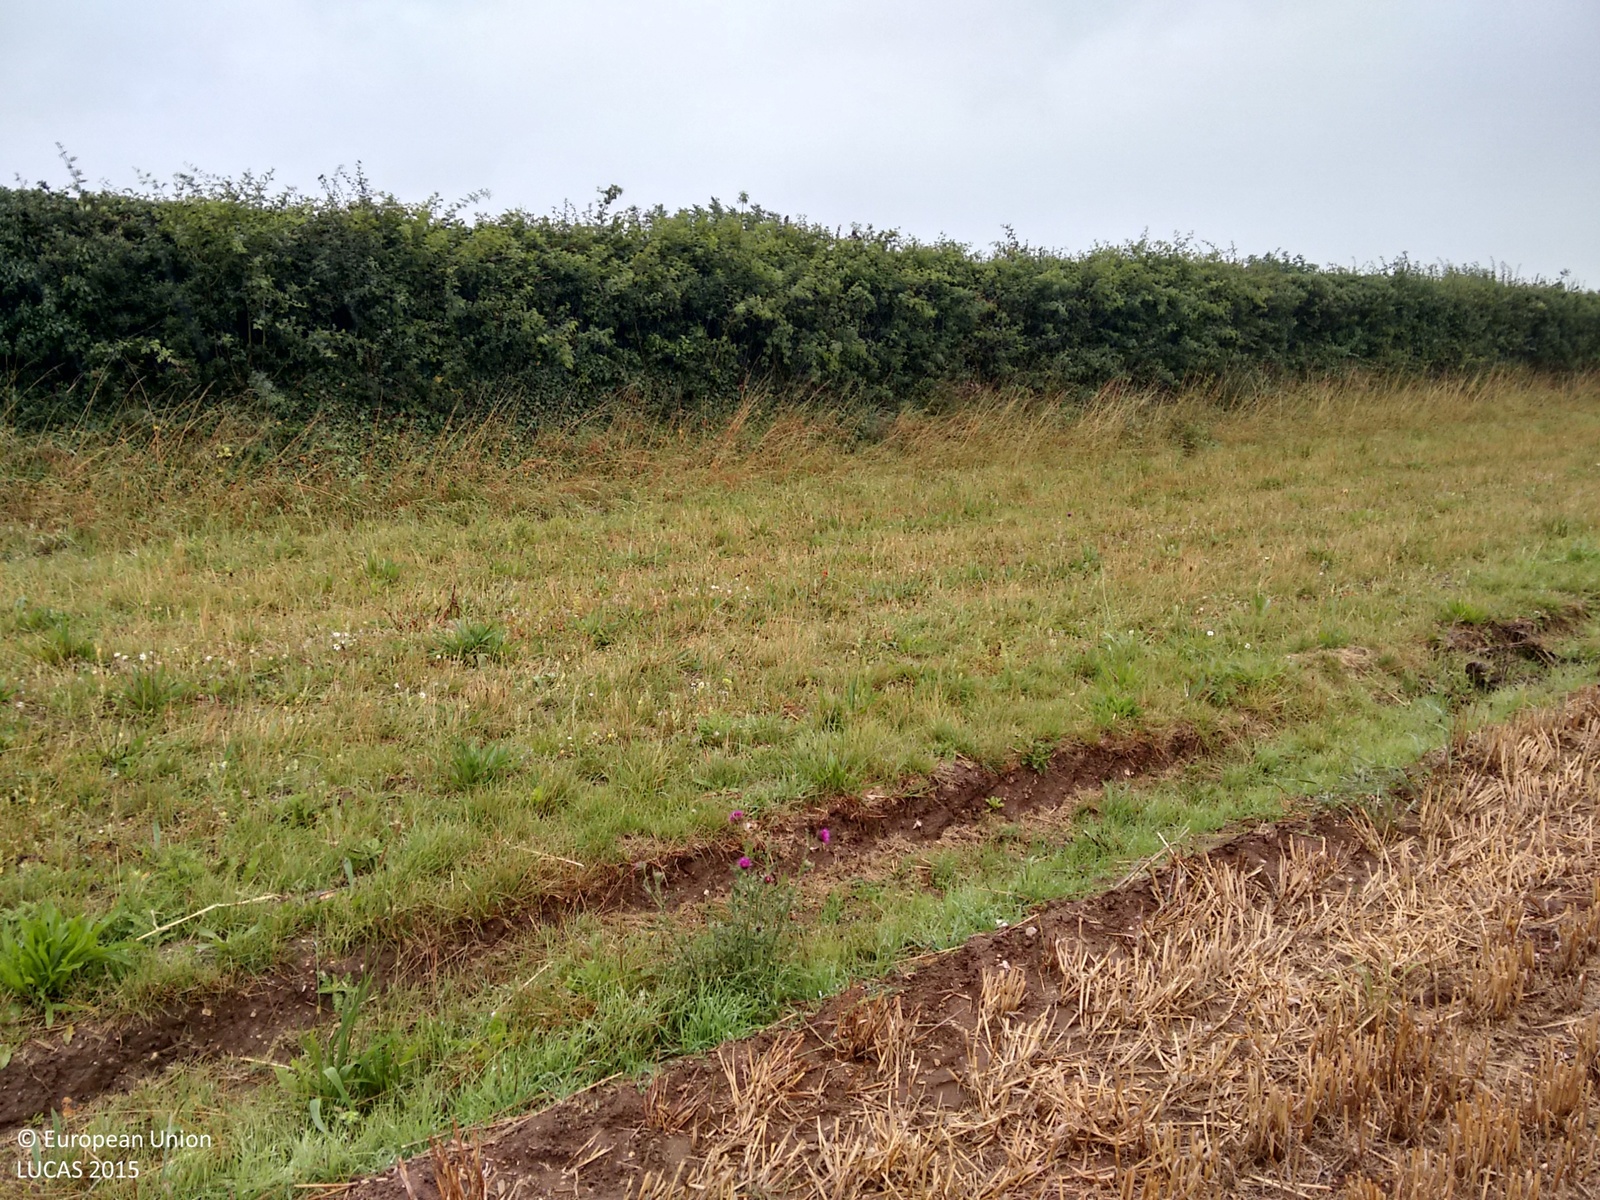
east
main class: Cropland
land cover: Common wheat
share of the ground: > 75 %
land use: Agriculture (excluding fallow land and kitchen gardens)
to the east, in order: Common wheat; Grassland without tree/shrub cover; Managed hedges; Grass margins; Paved roads, cycling and walking lanes; Grass margins; Managed hedges; Grassland without tree/shrub cover; Common wheat
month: August
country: GB
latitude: 52.9375
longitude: 0.7350
